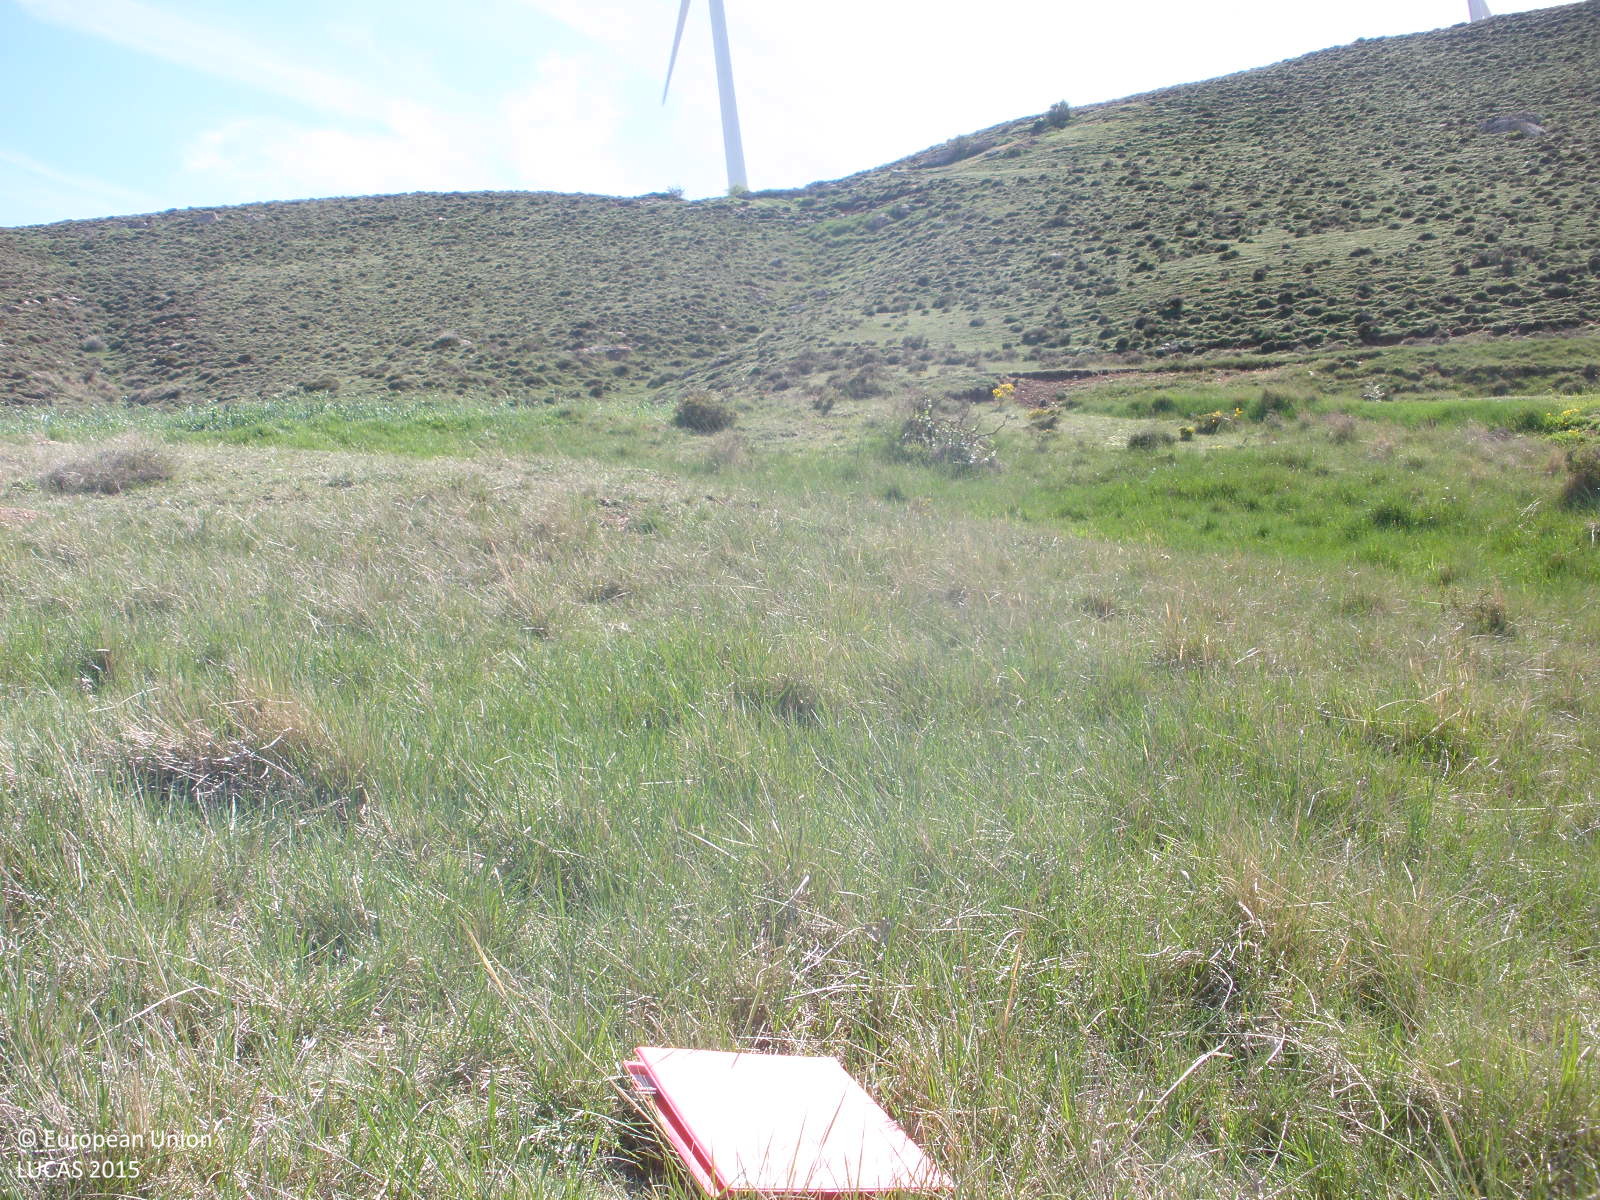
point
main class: Grassland
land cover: Grassland without tree/shrub cover
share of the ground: > 75 %
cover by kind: herbaceous plants 100 %
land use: Semi-natural and natural areas not in use
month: May
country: ES
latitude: 40.7167
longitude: -0.8920
